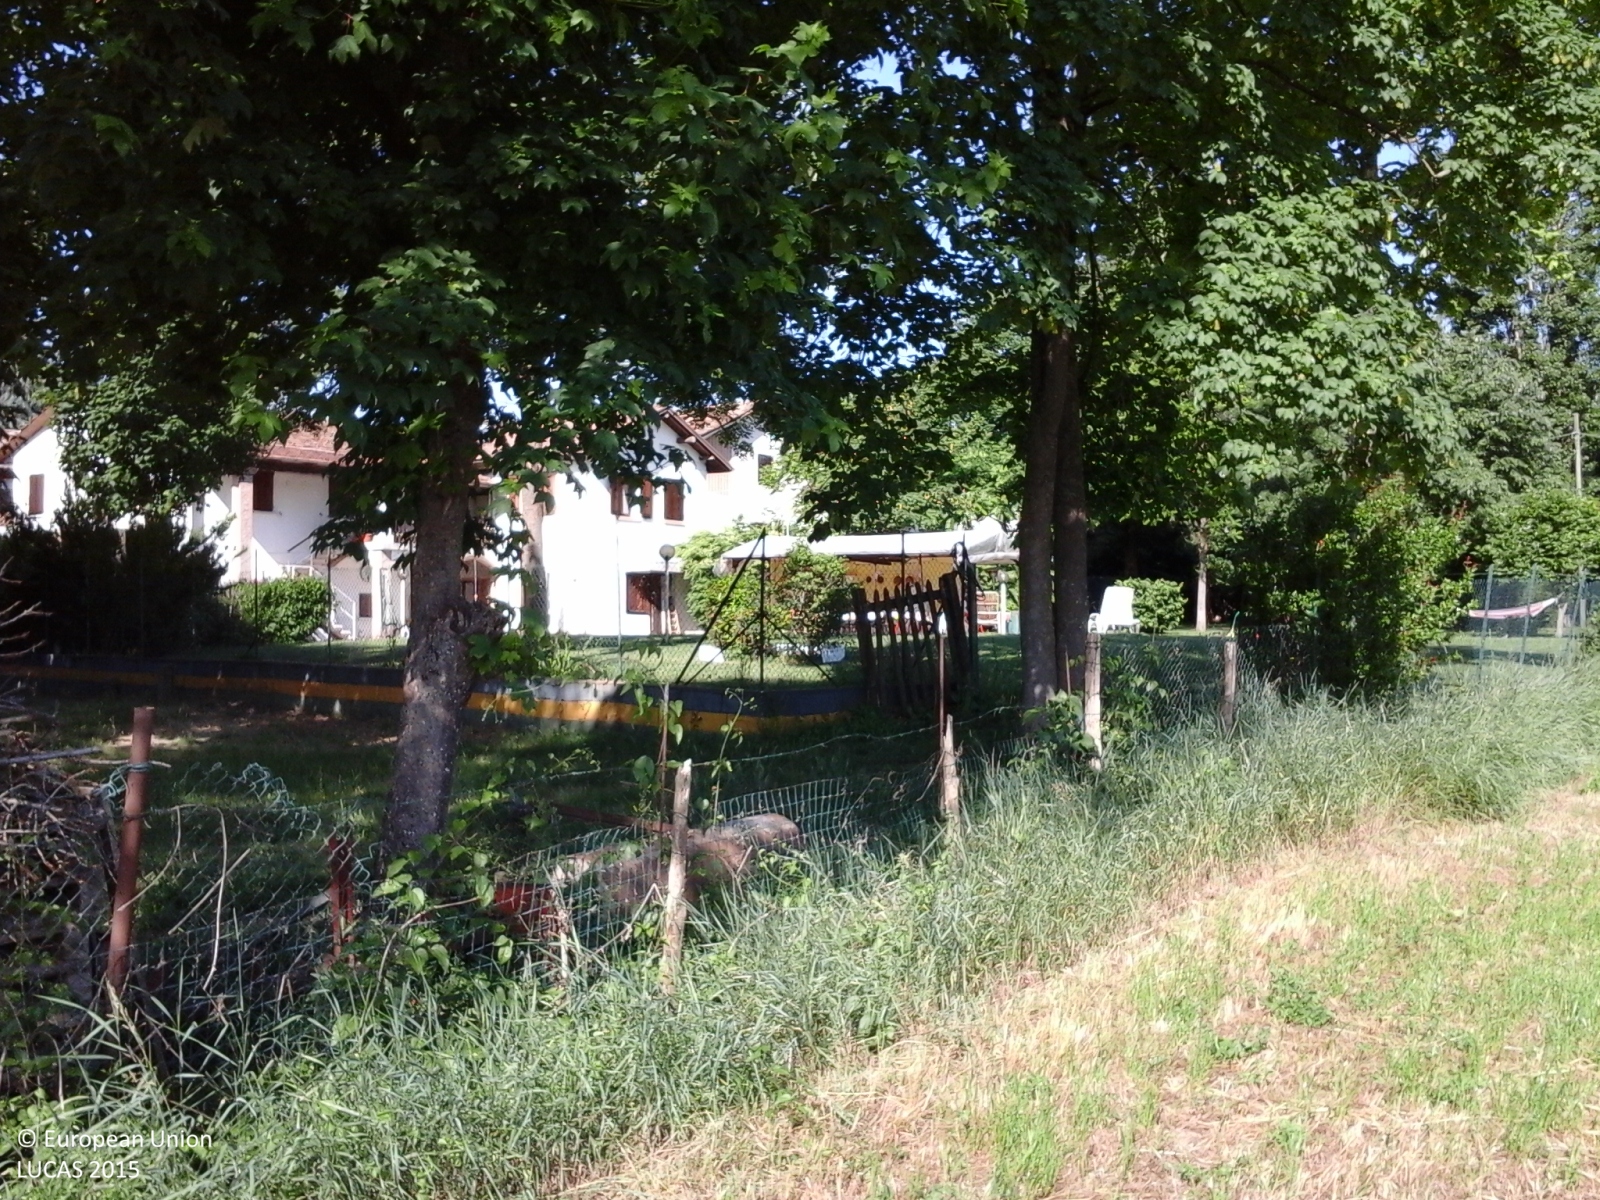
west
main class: Cropland
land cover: Lucerne
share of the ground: > 75 %
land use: Agriculture (excluding fallow land and kitchen gardens)
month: May
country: IT
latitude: 44.6011
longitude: 10.6411
